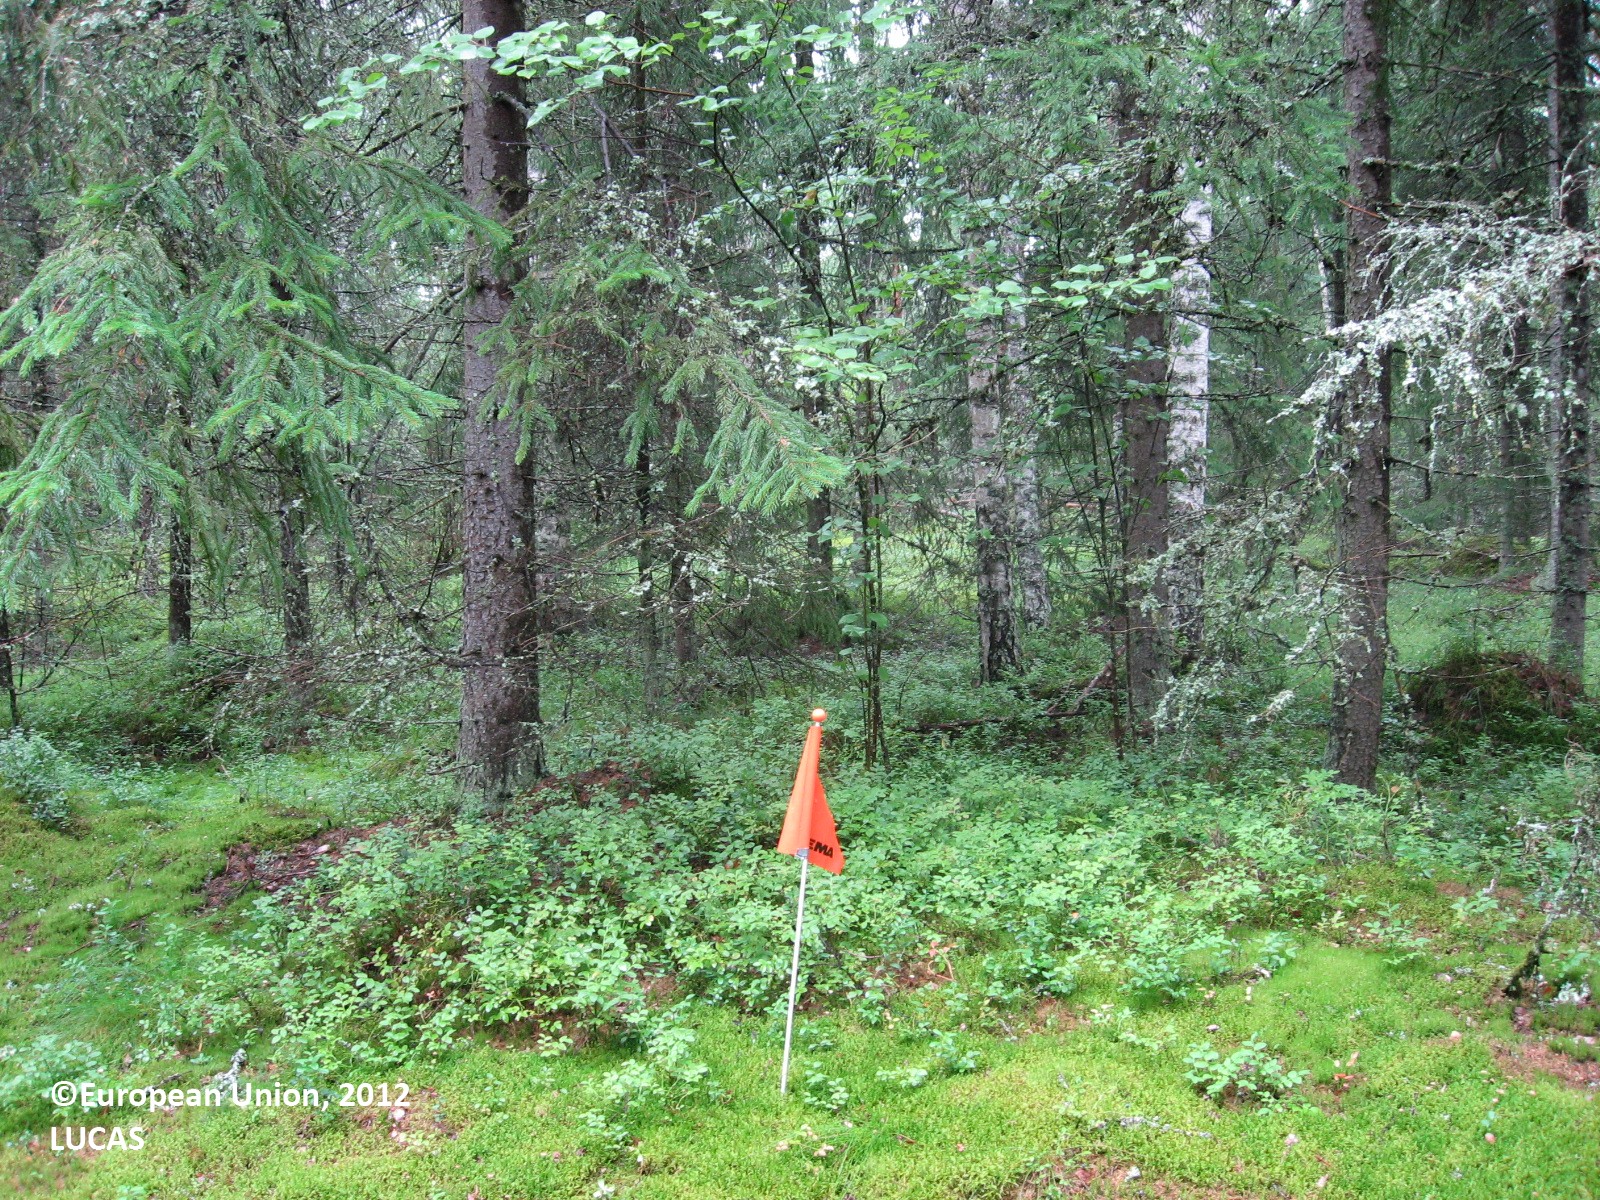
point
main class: Woodland
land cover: Spruce dominated coniferous woodland
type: boreal forest
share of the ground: > 75 %
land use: Forestry
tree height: > 5 m
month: August
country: FI
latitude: 60.5317
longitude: 25.4911
